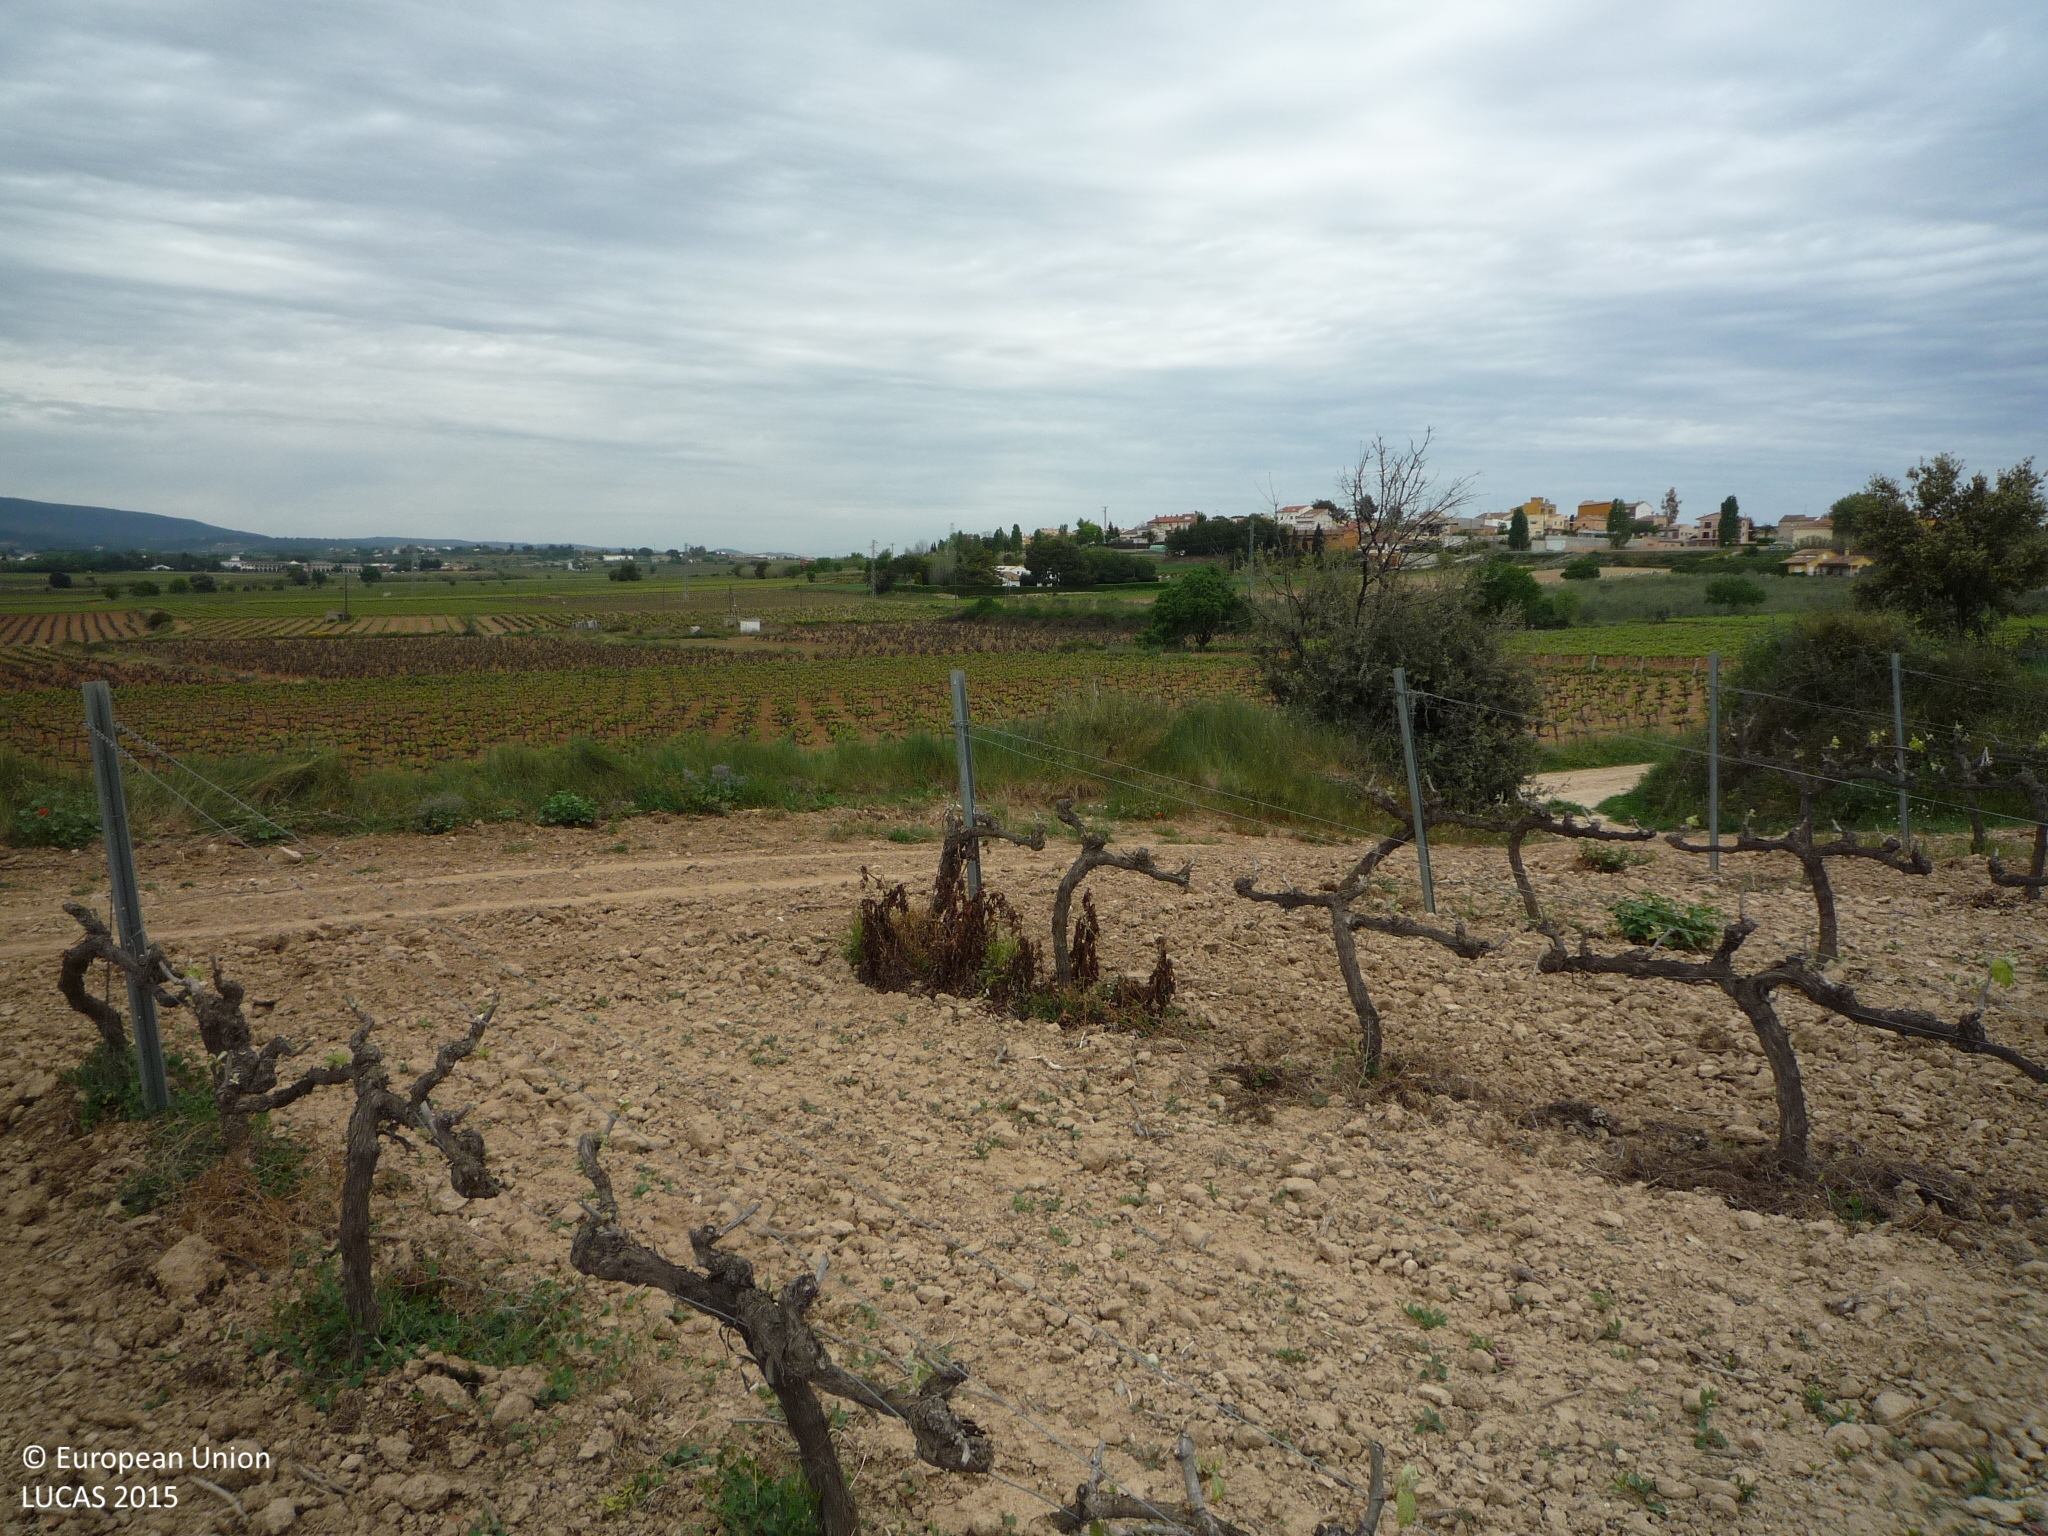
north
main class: Cropland
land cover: Vineyards
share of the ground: 10 - 25 %
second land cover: Other bare soil
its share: > 75 %
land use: Agriculture (excluding fallow land and kitchen gardens)
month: April
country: ES
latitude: 41.3676
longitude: 1.6845
